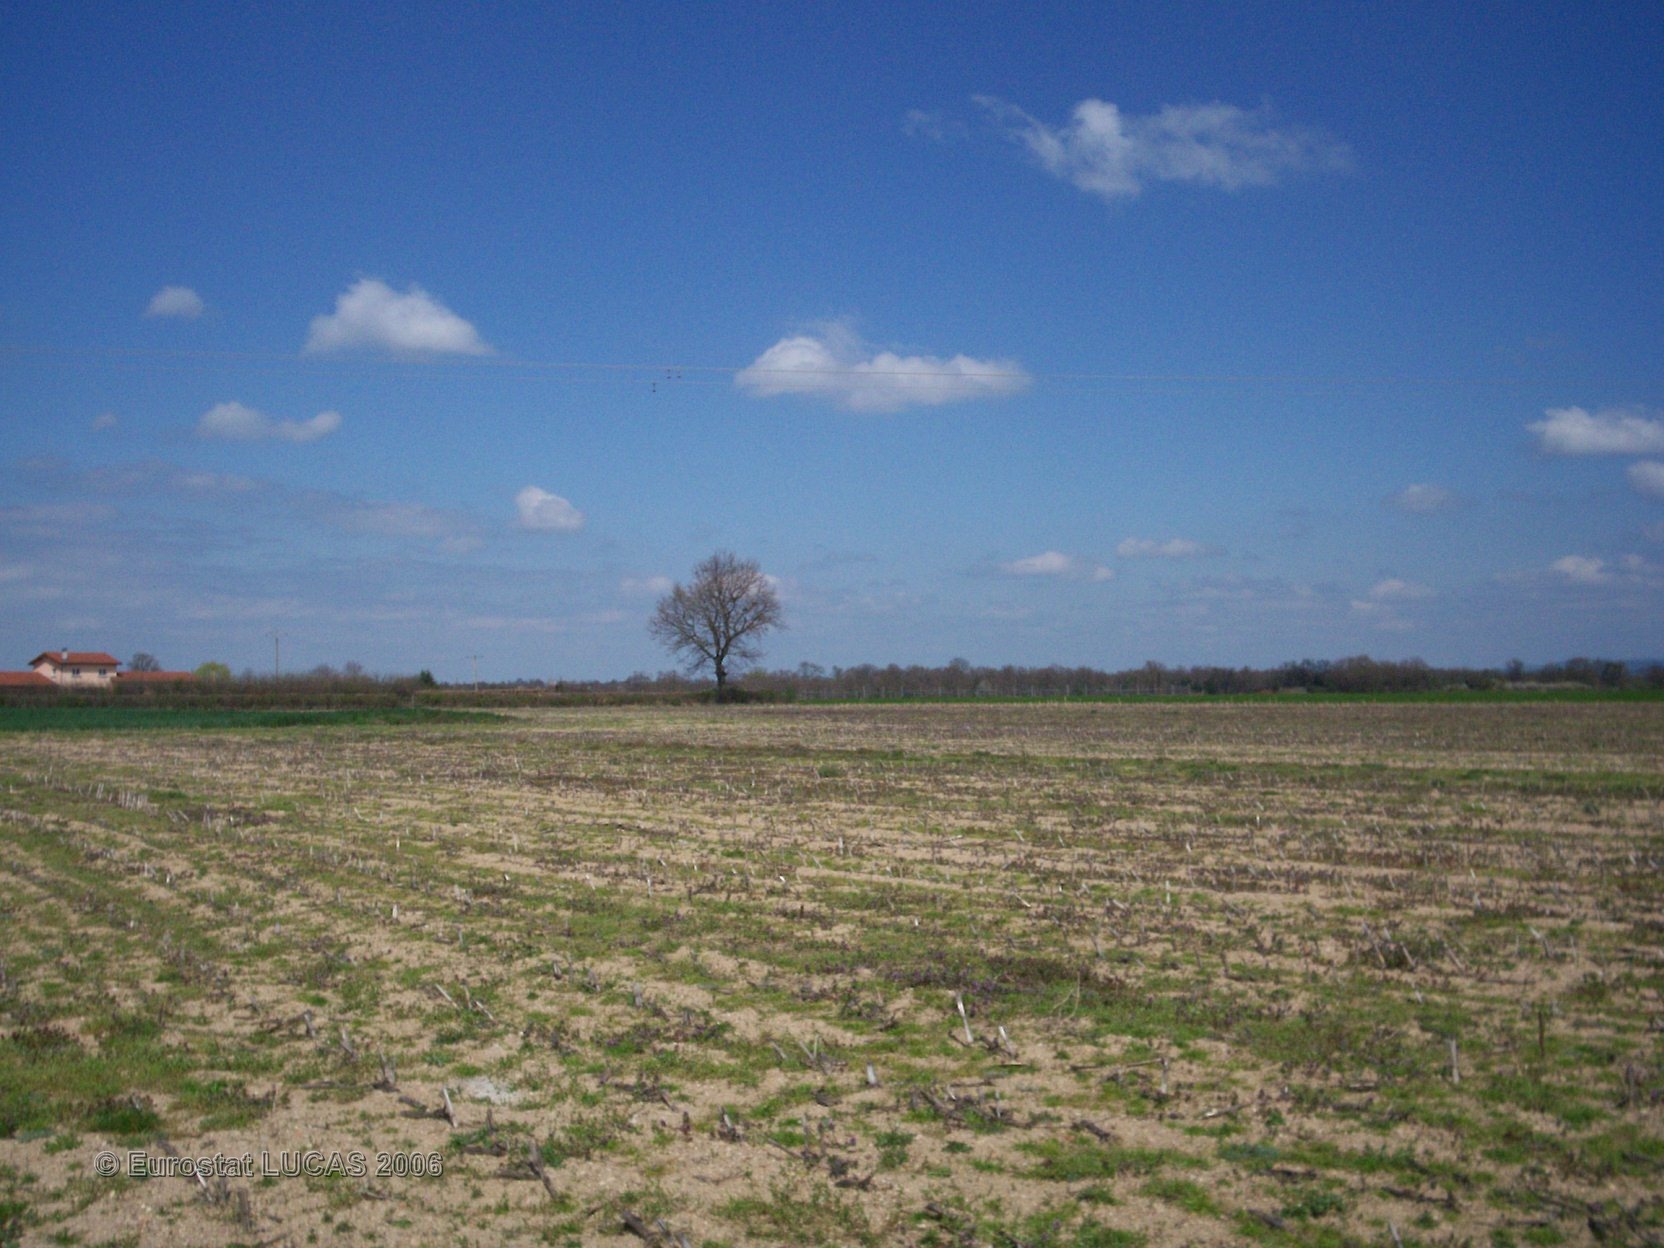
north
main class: Bare land
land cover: Bare land
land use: Fallow land
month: April
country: FR
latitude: 45.7385
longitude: 4.1292
